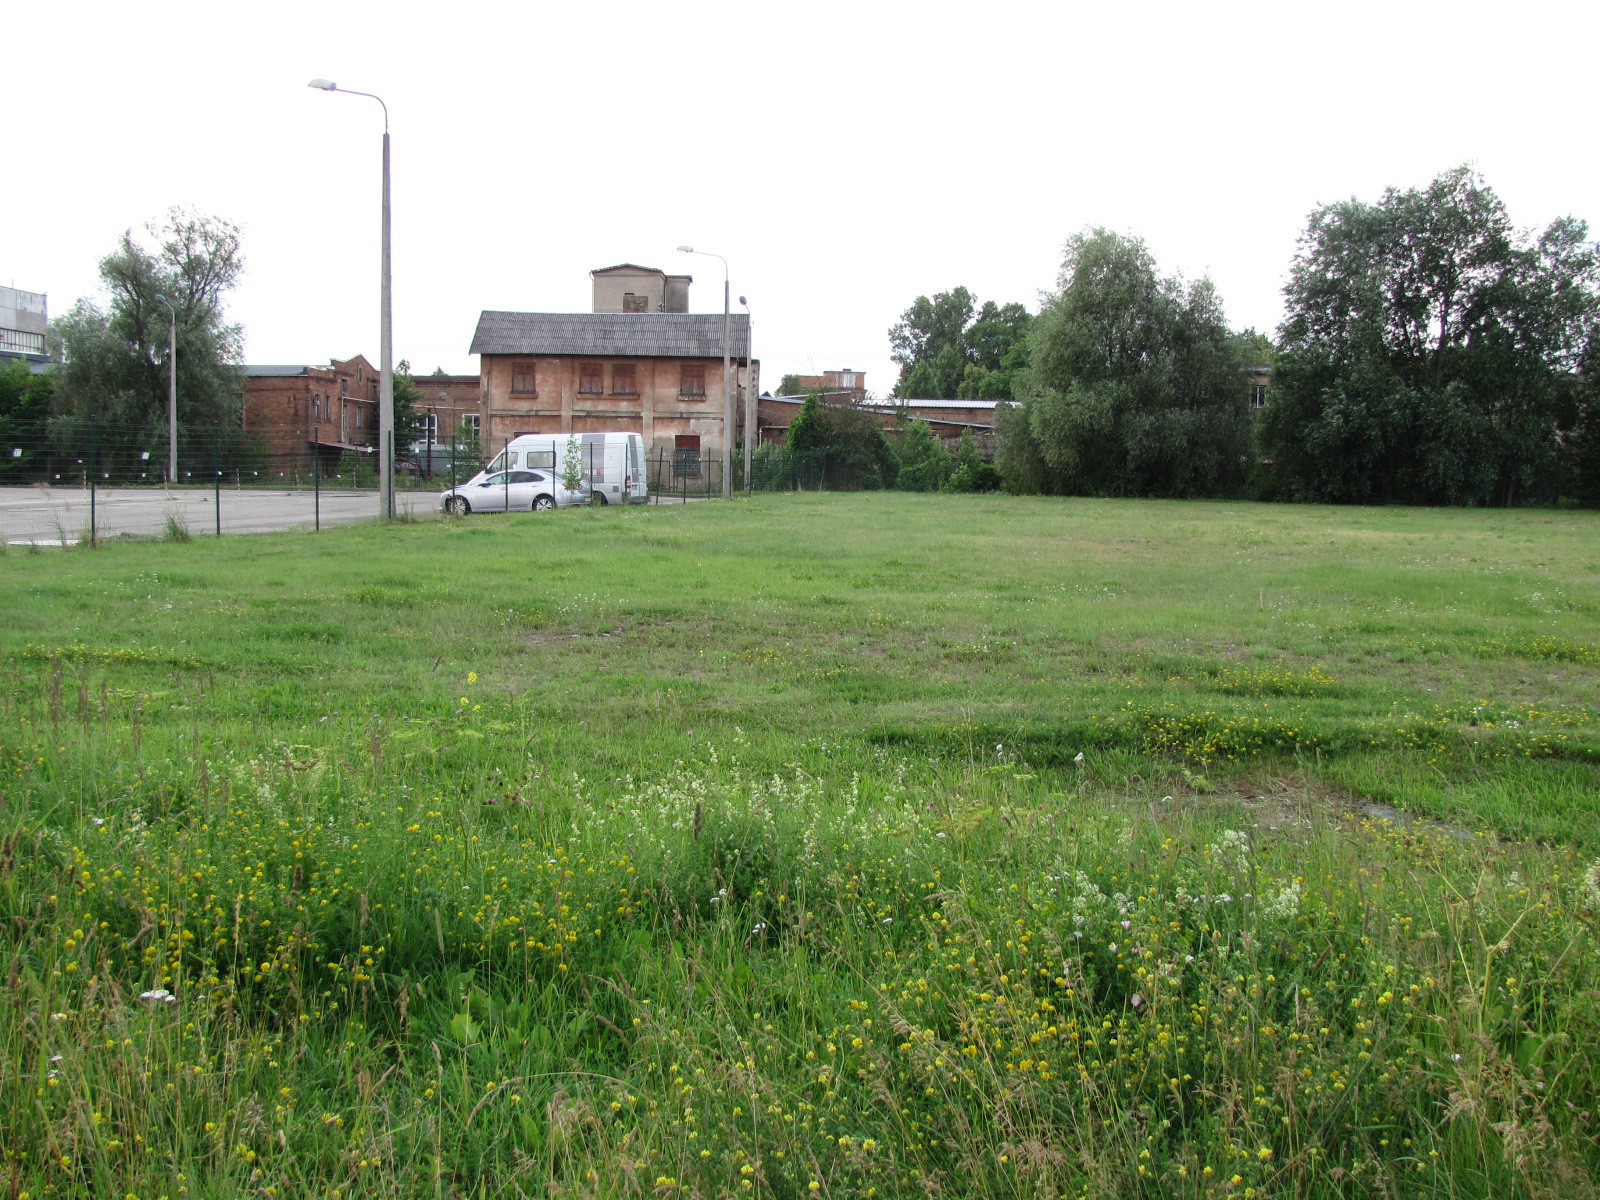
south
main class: Grassland
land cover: Grassland without tree/shrub cover
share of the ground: > 75 %
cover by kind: herbaceous plants 100 %
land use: Community services
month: July
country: LV
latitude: 56.9923
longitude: 24.1253
